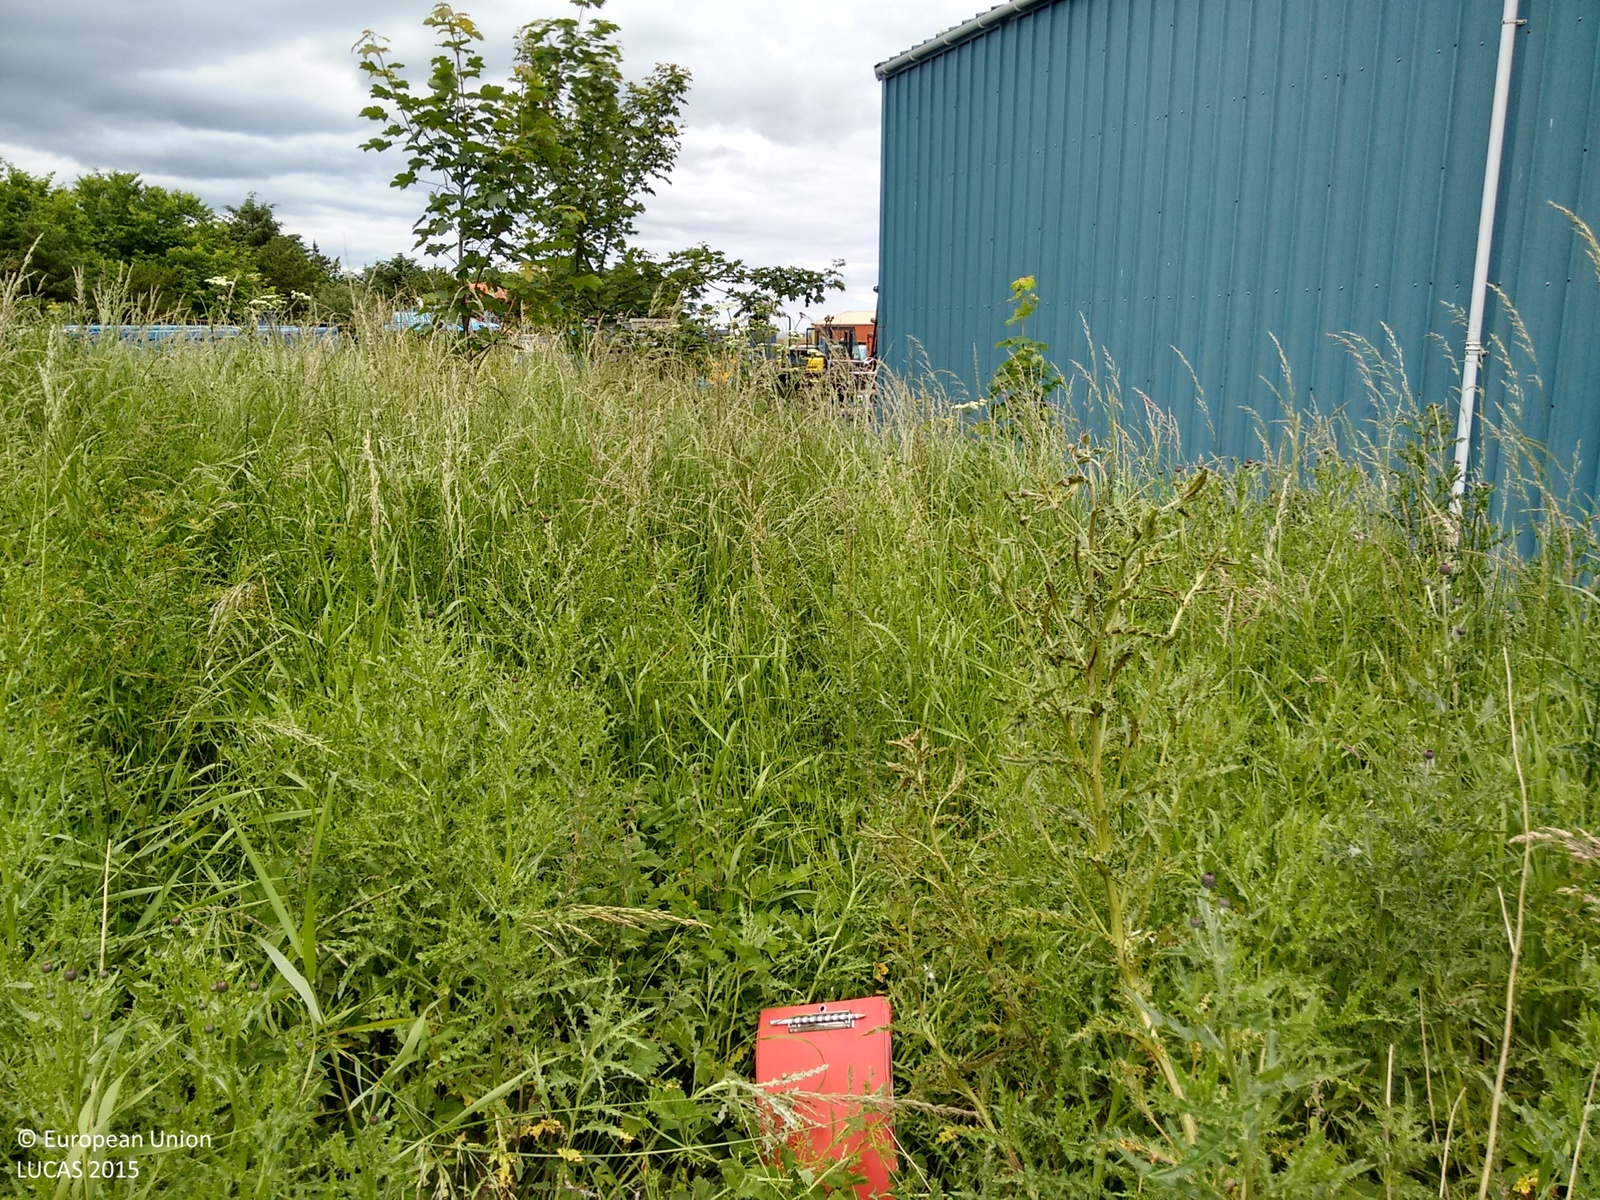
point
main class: Grassland
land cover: Grassland with sparse tree/shrub cover
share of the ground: > 75 %
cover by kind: herbaceous plants 90 %, broadleaved forest trees 5 %, shrubs 5 %
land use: Semi-natural and natural areas not in use
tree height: > 5 m
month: July
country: GB
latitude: 57.5145
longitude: -1.8114
